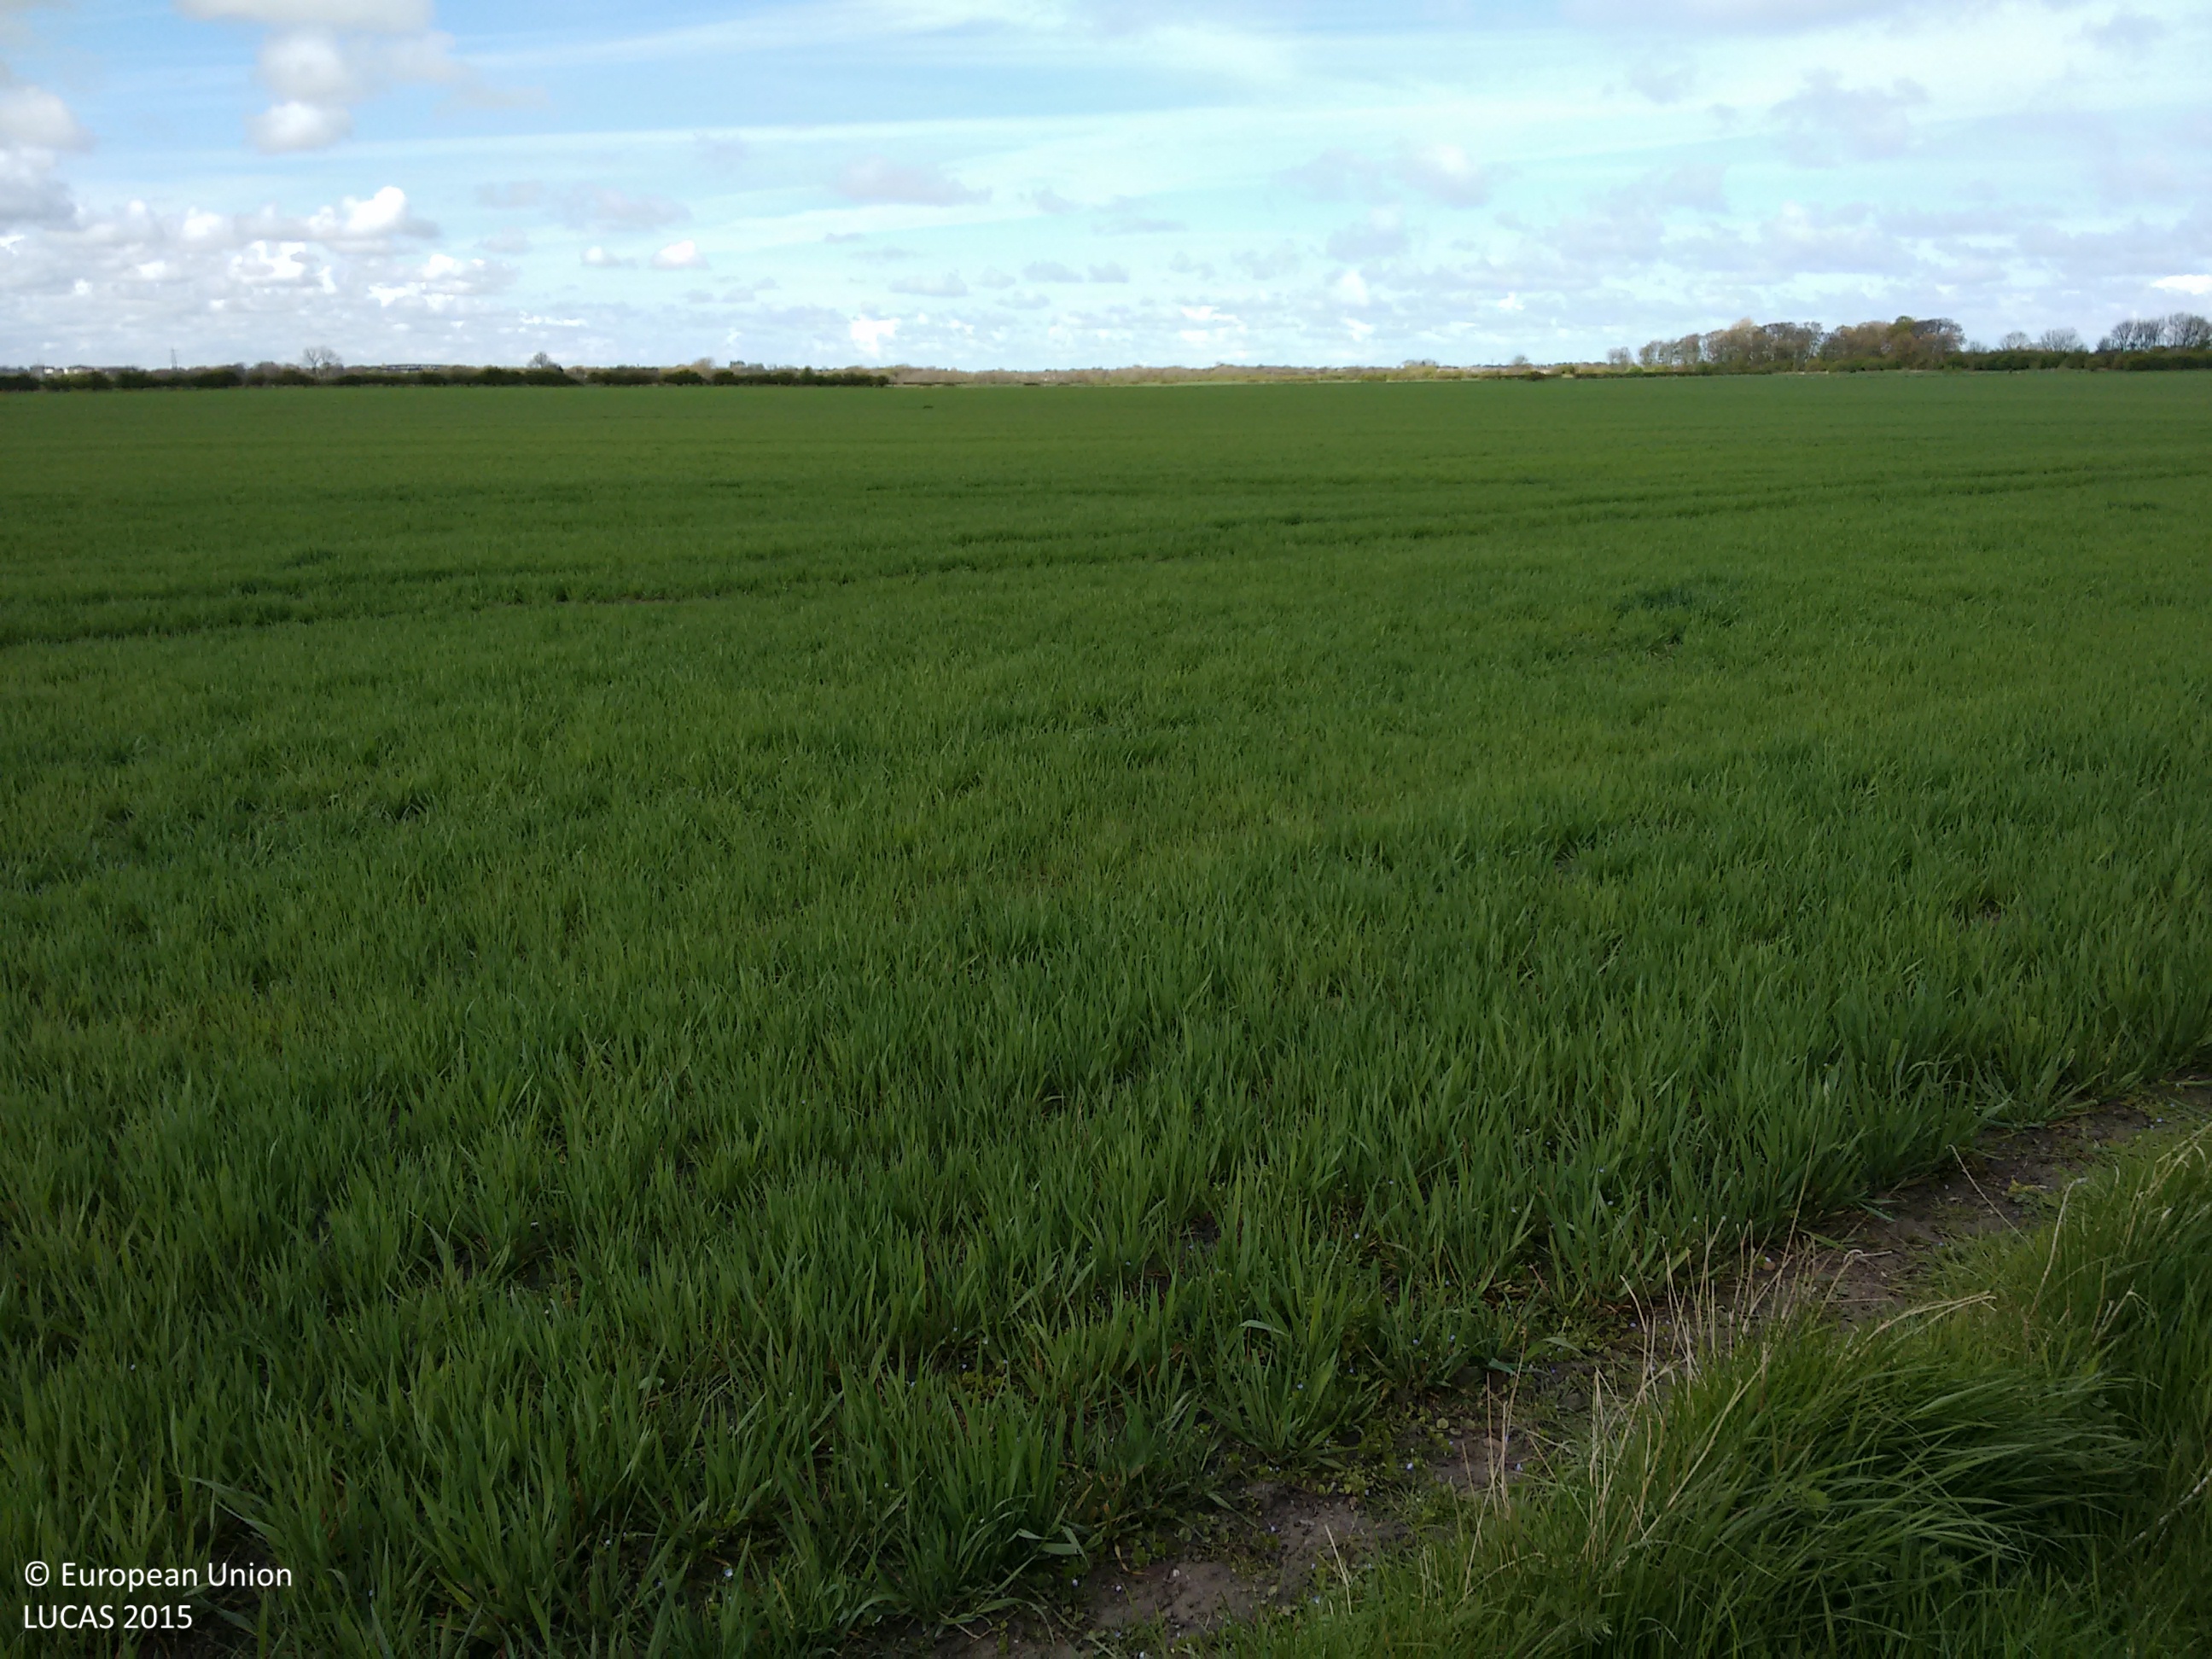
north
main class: Cropland
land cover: Oats
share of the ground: > 75 %
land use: Agriculture (excluding fallow land and kitchen gardens)
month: May
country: GB
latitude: 55.0488
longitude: -1.5203
